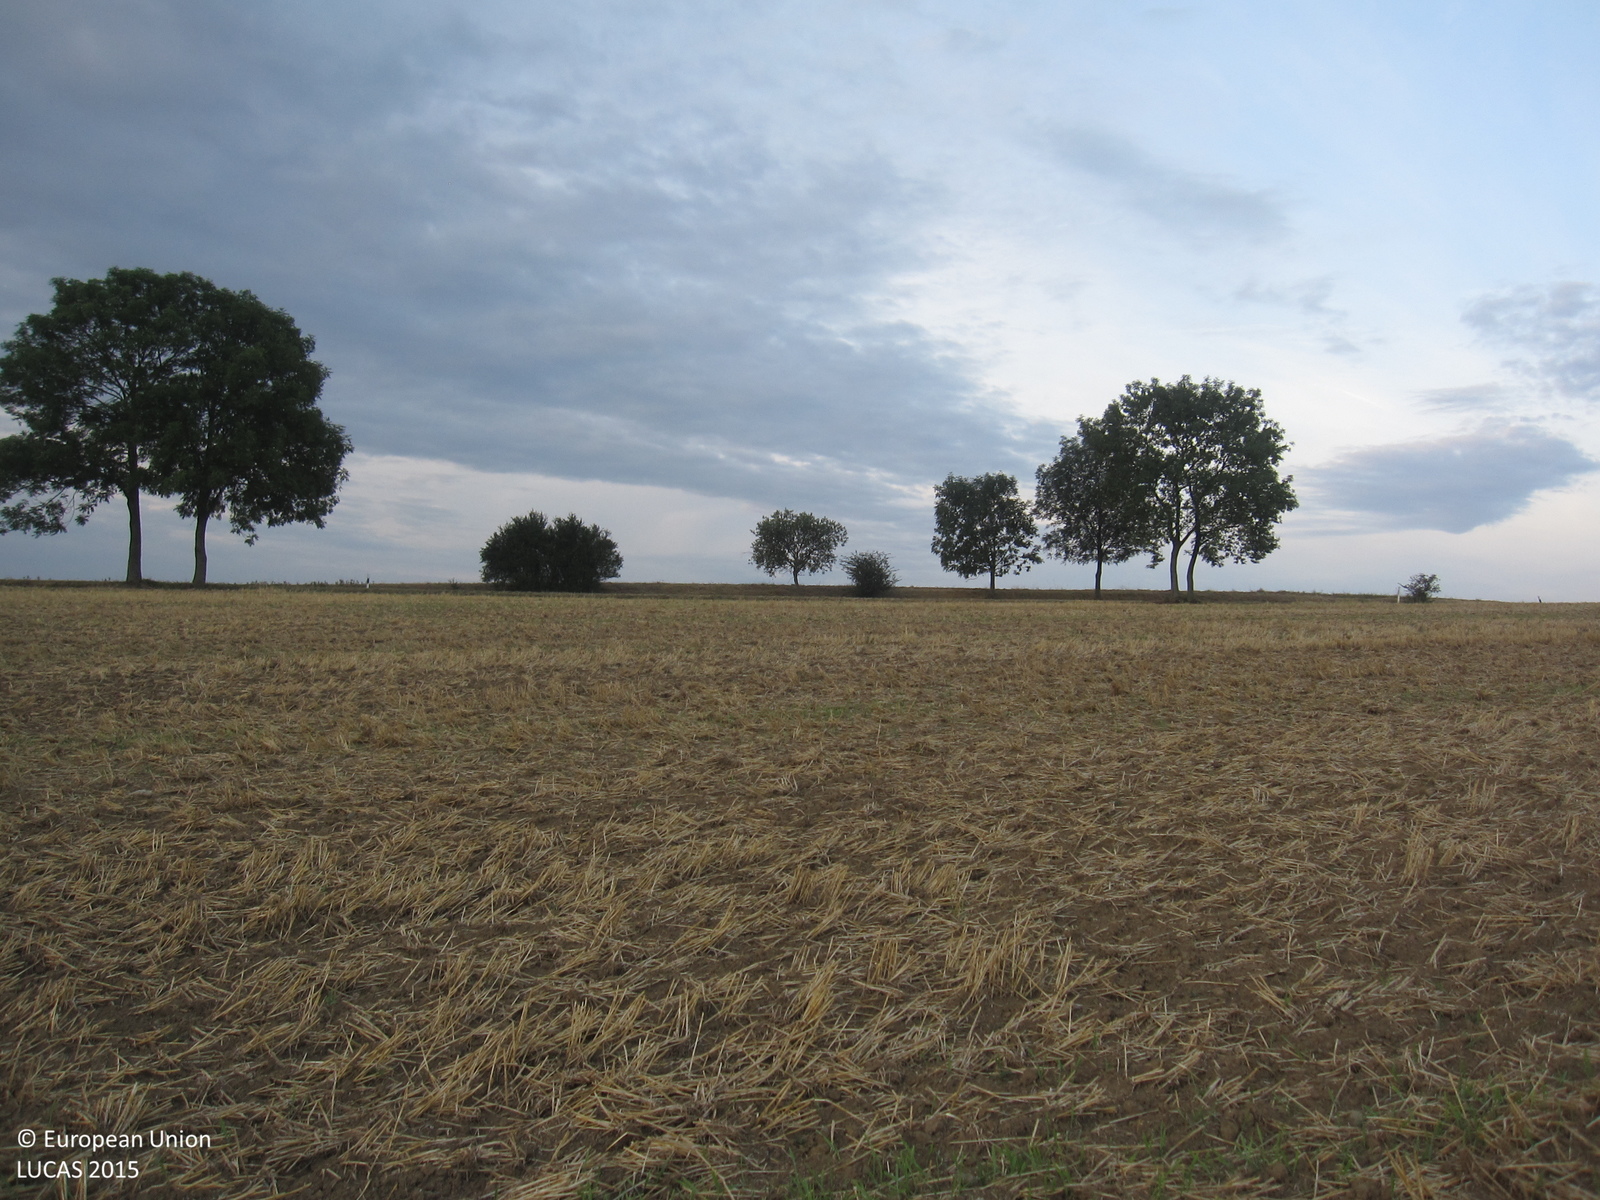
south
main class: Cropland
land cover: Durum wheat
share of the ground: 25 - 50 %
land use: Agriculture (excluding fallow land and kitchen gardens)
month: August
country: DE
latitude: 50.4717
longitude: 12.0427
